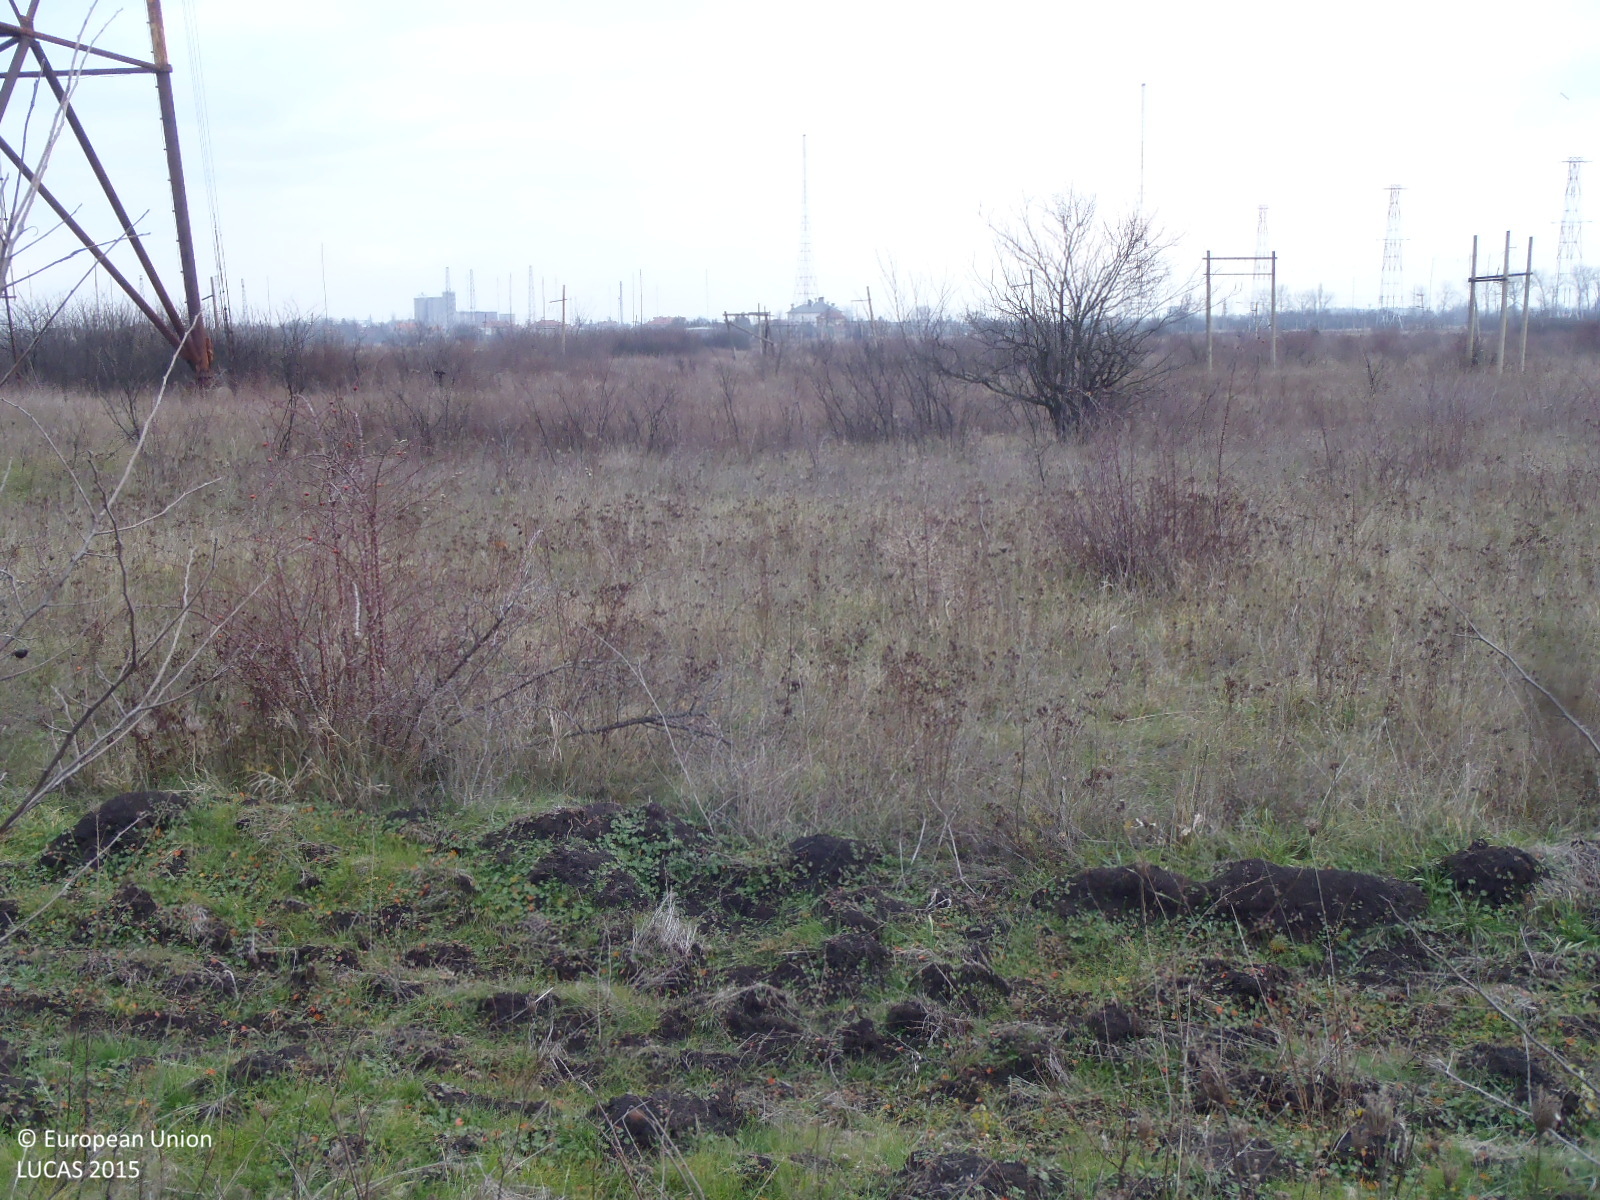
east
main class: Grassland
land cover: Grassland with sparse tree/shrub cover
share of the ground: > 75 %
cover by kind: herbaceous plants 85 %, shrubs 10 %, broadleaved forest trees 5 %
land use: Community services
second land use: Telecommunication
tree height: < 5 m
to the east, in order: Grassland with sparse tree/shrub cover; Electric lines; Grassland with sparse tree/shrub cover; Electric lines; Grassland with sparse tree/shrub cover
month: December
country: BG
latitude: 42.8118
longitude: 23.1800
